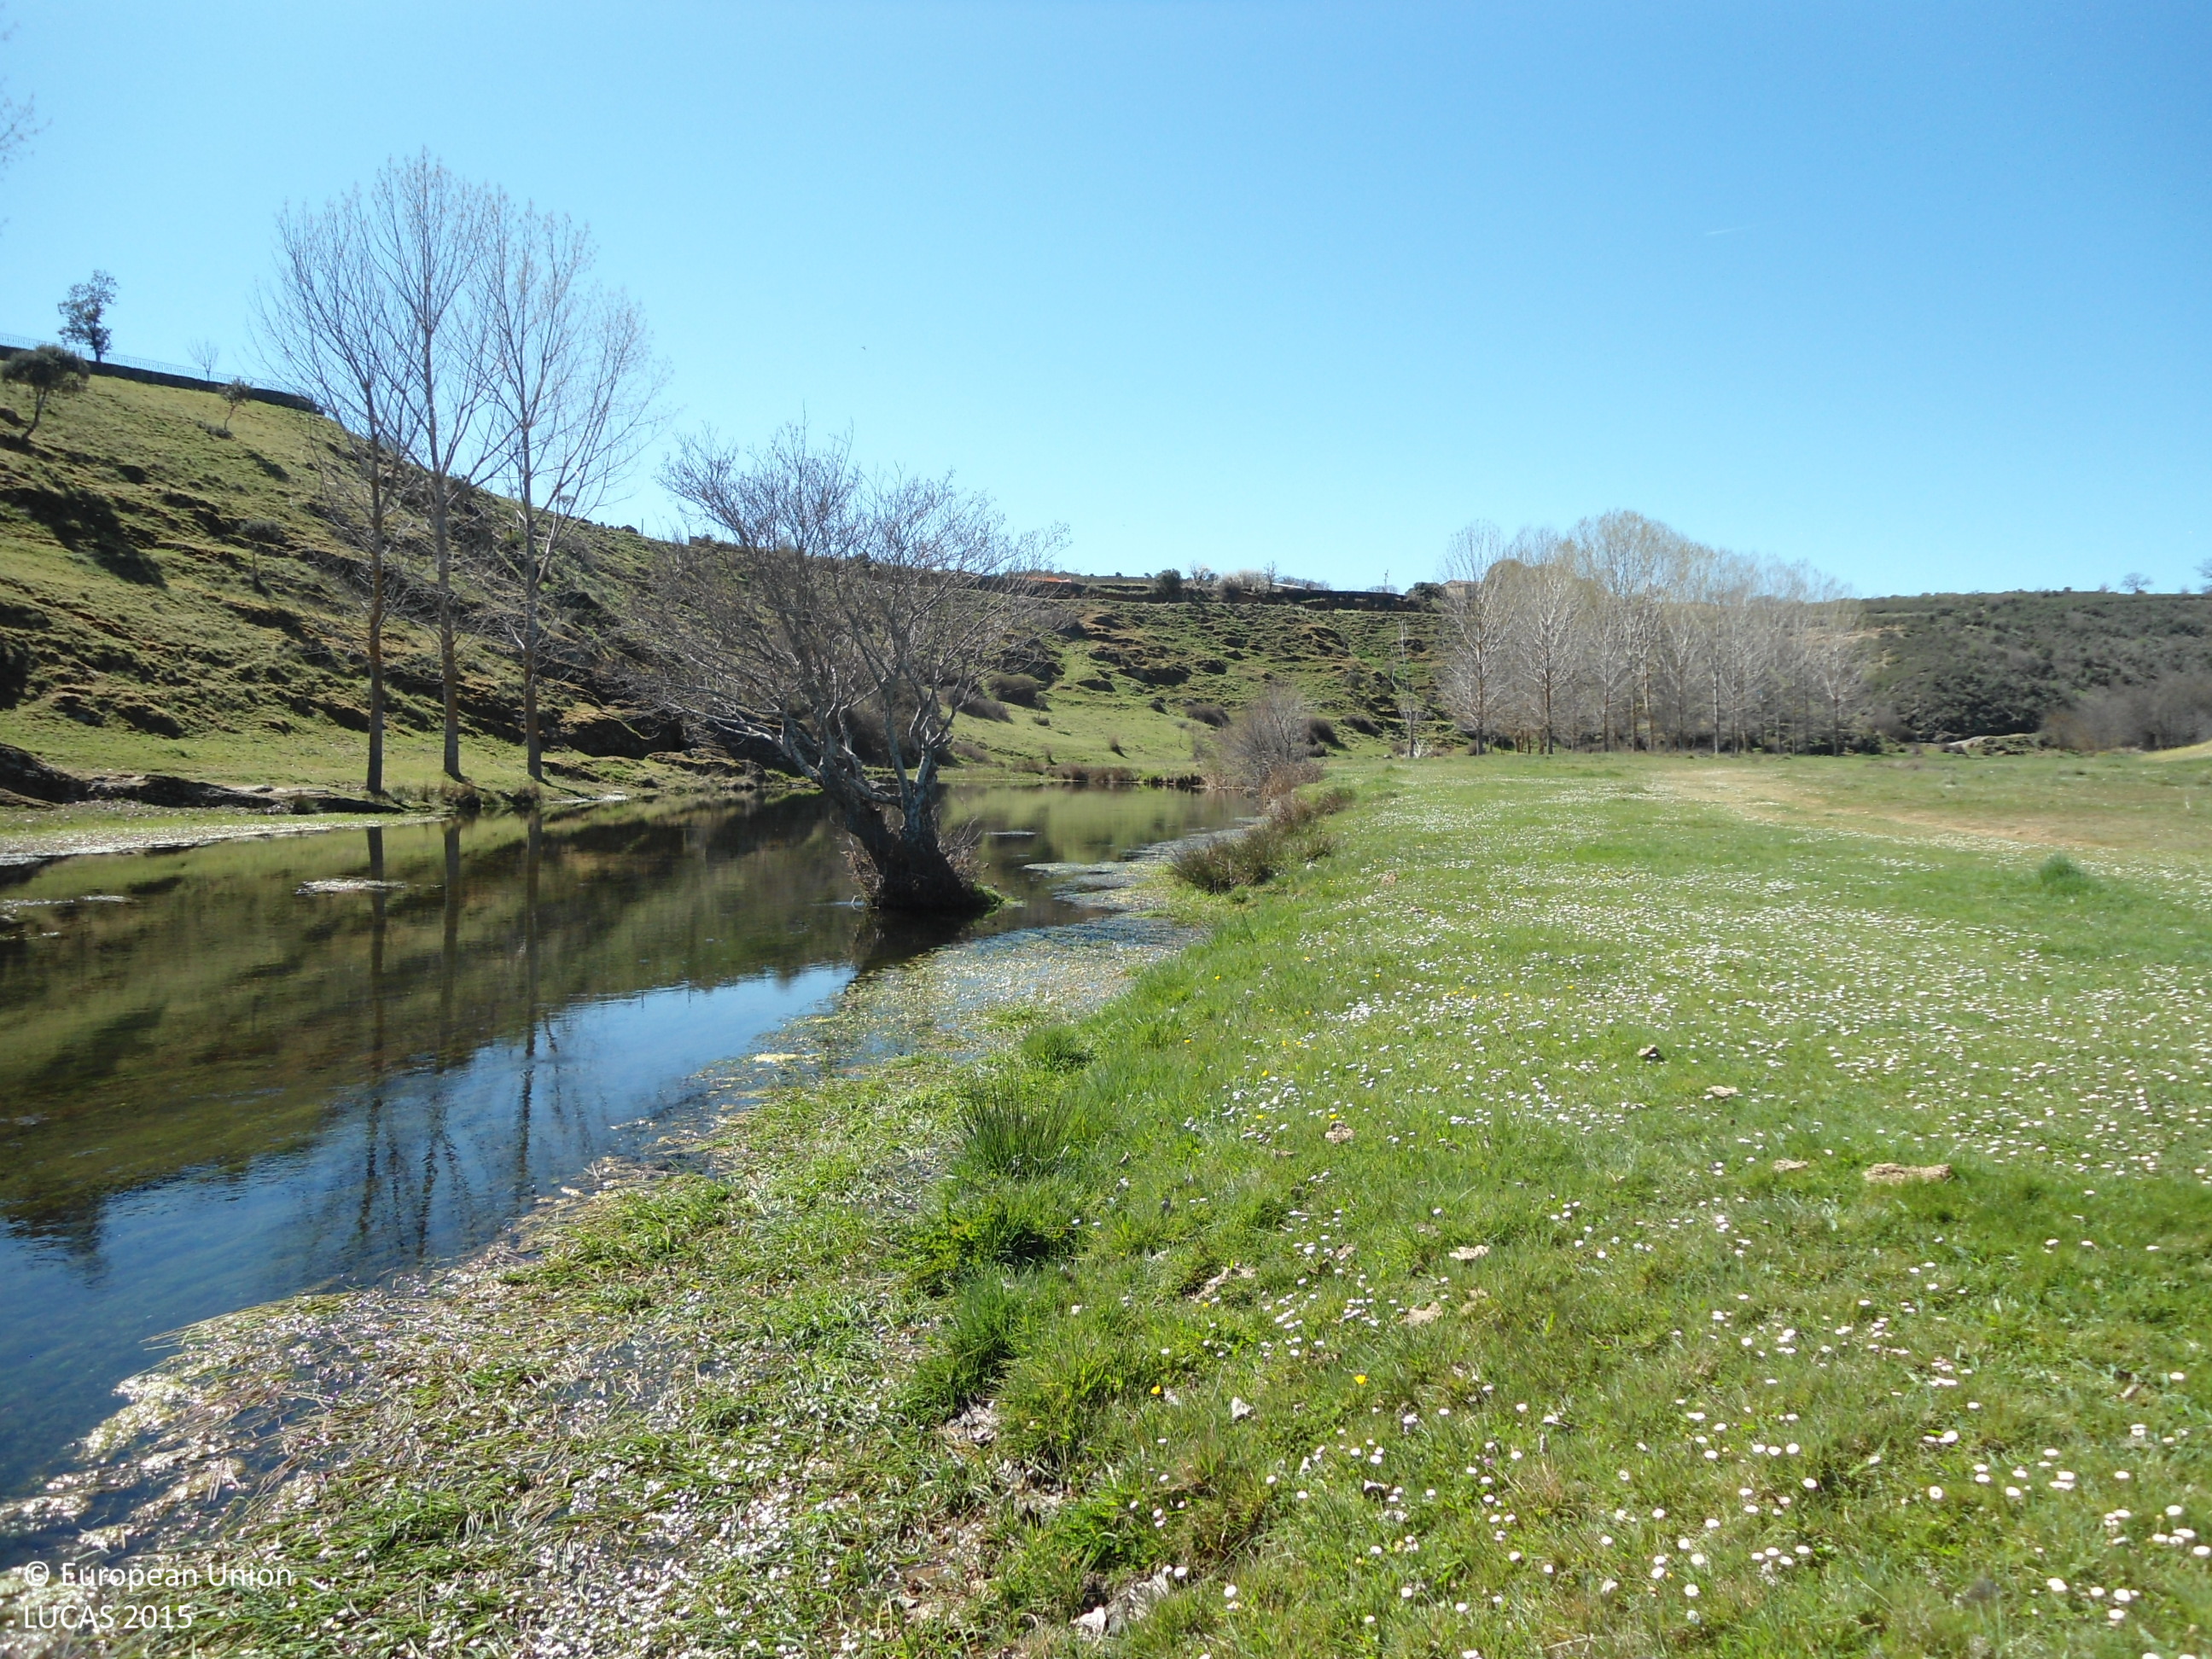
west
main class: Grassland
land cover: Grassland without tree/shrub cover
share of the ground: > 75 %
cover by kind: herbaceous plants 100 %
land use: Agriculture (excluding fallow land and kitchen gardens)
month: April
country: ES
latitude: 41.7166
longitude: -6.1440
